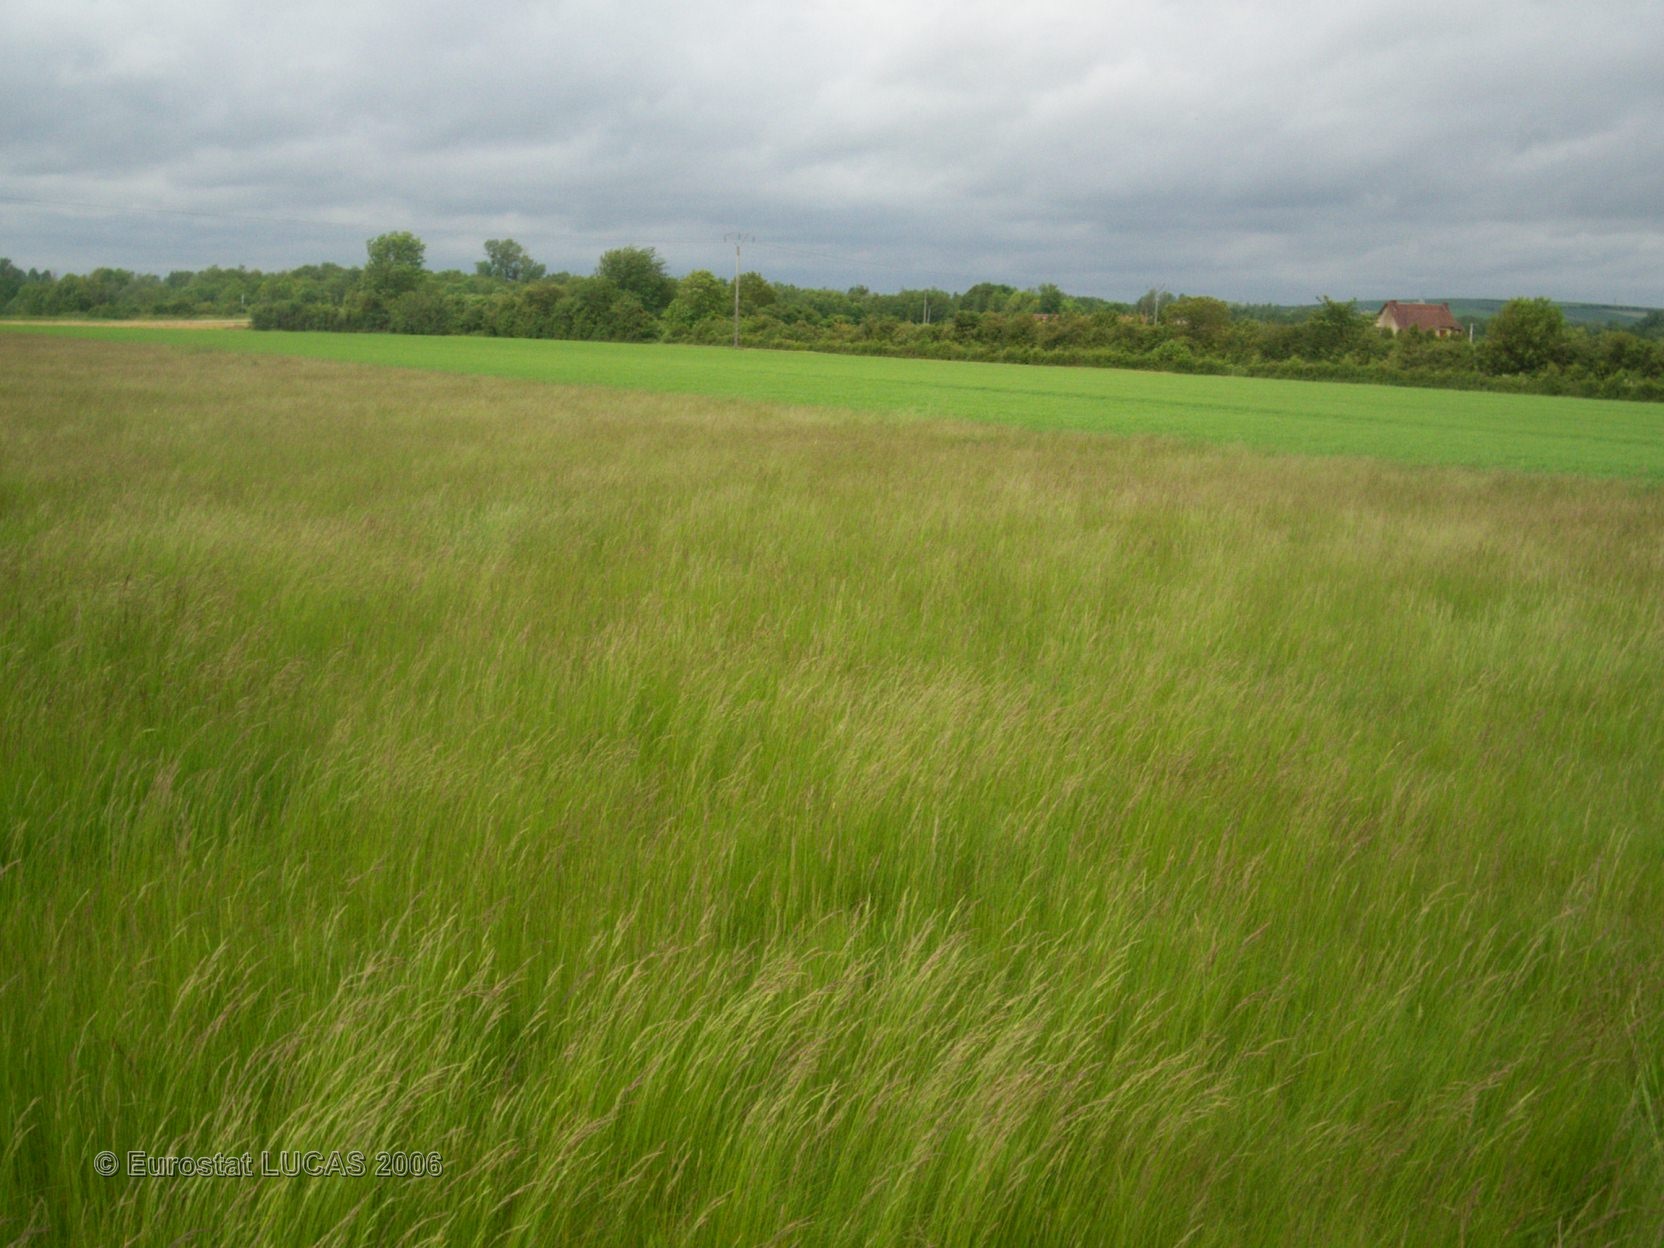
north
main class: Grassland
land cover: Grassland without tree/shrub cover
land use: Agriculture (excluding fallow land and kitchen gardens)
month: May
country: FR
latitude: 48.3663
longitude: 3.9892
